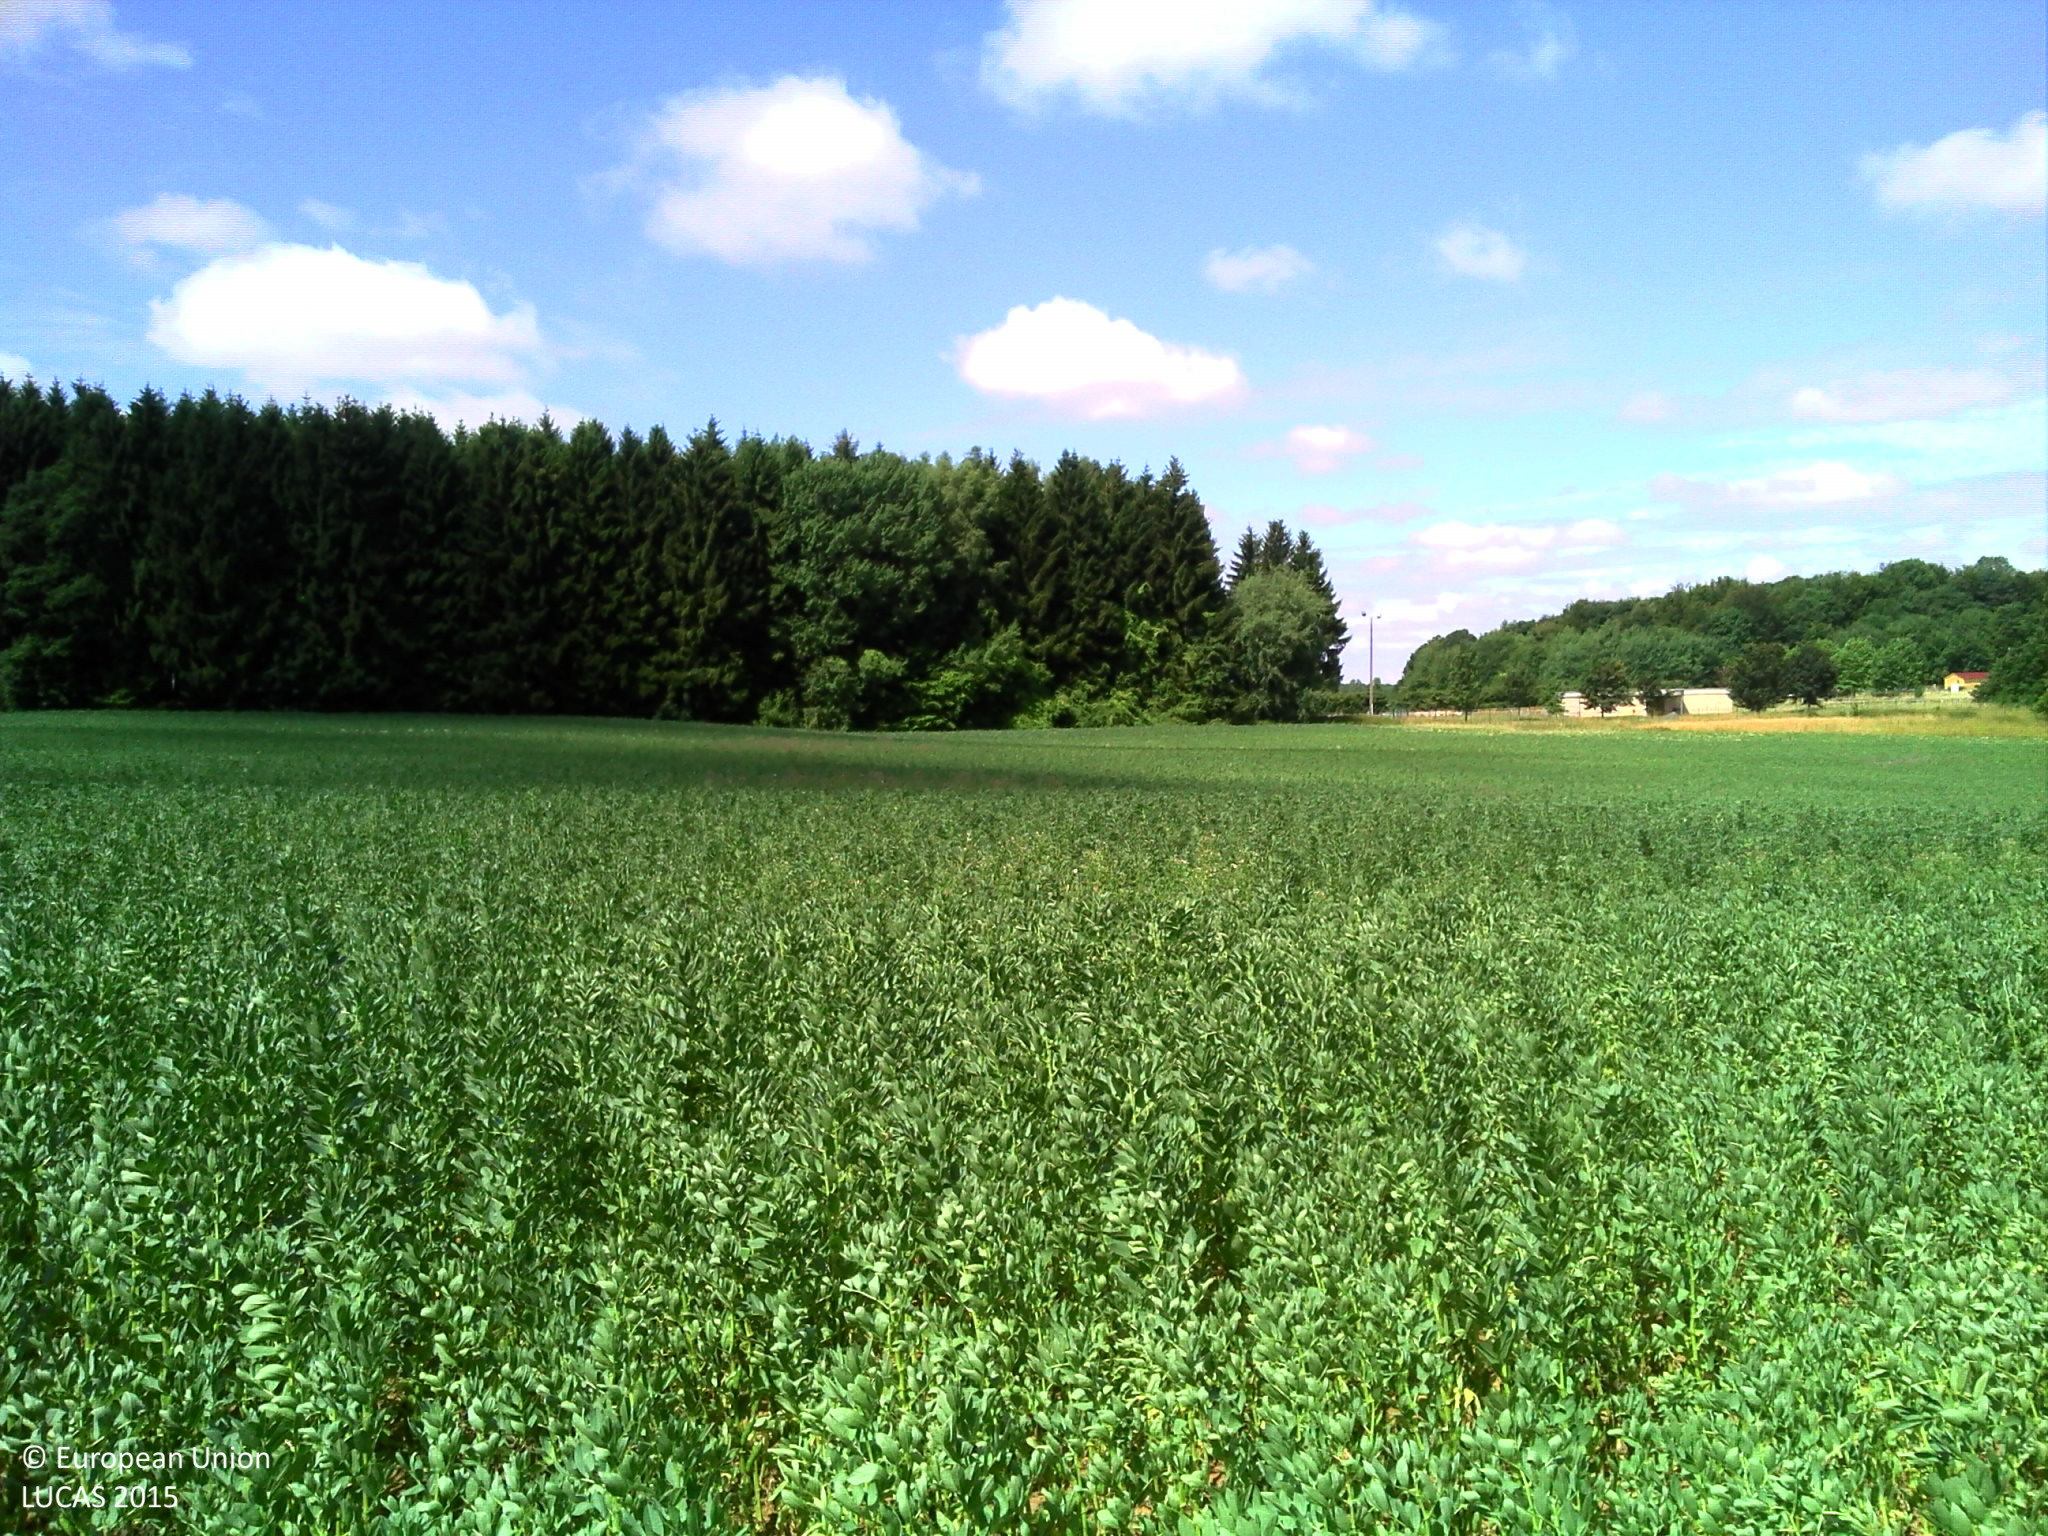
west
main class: Cropland
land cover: Dry pulses
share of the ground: > 75 %
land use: Agriculture (excluding fallow land and kitchen gardens)
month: July
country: FR
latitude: 49.4623
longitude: 5.9014
